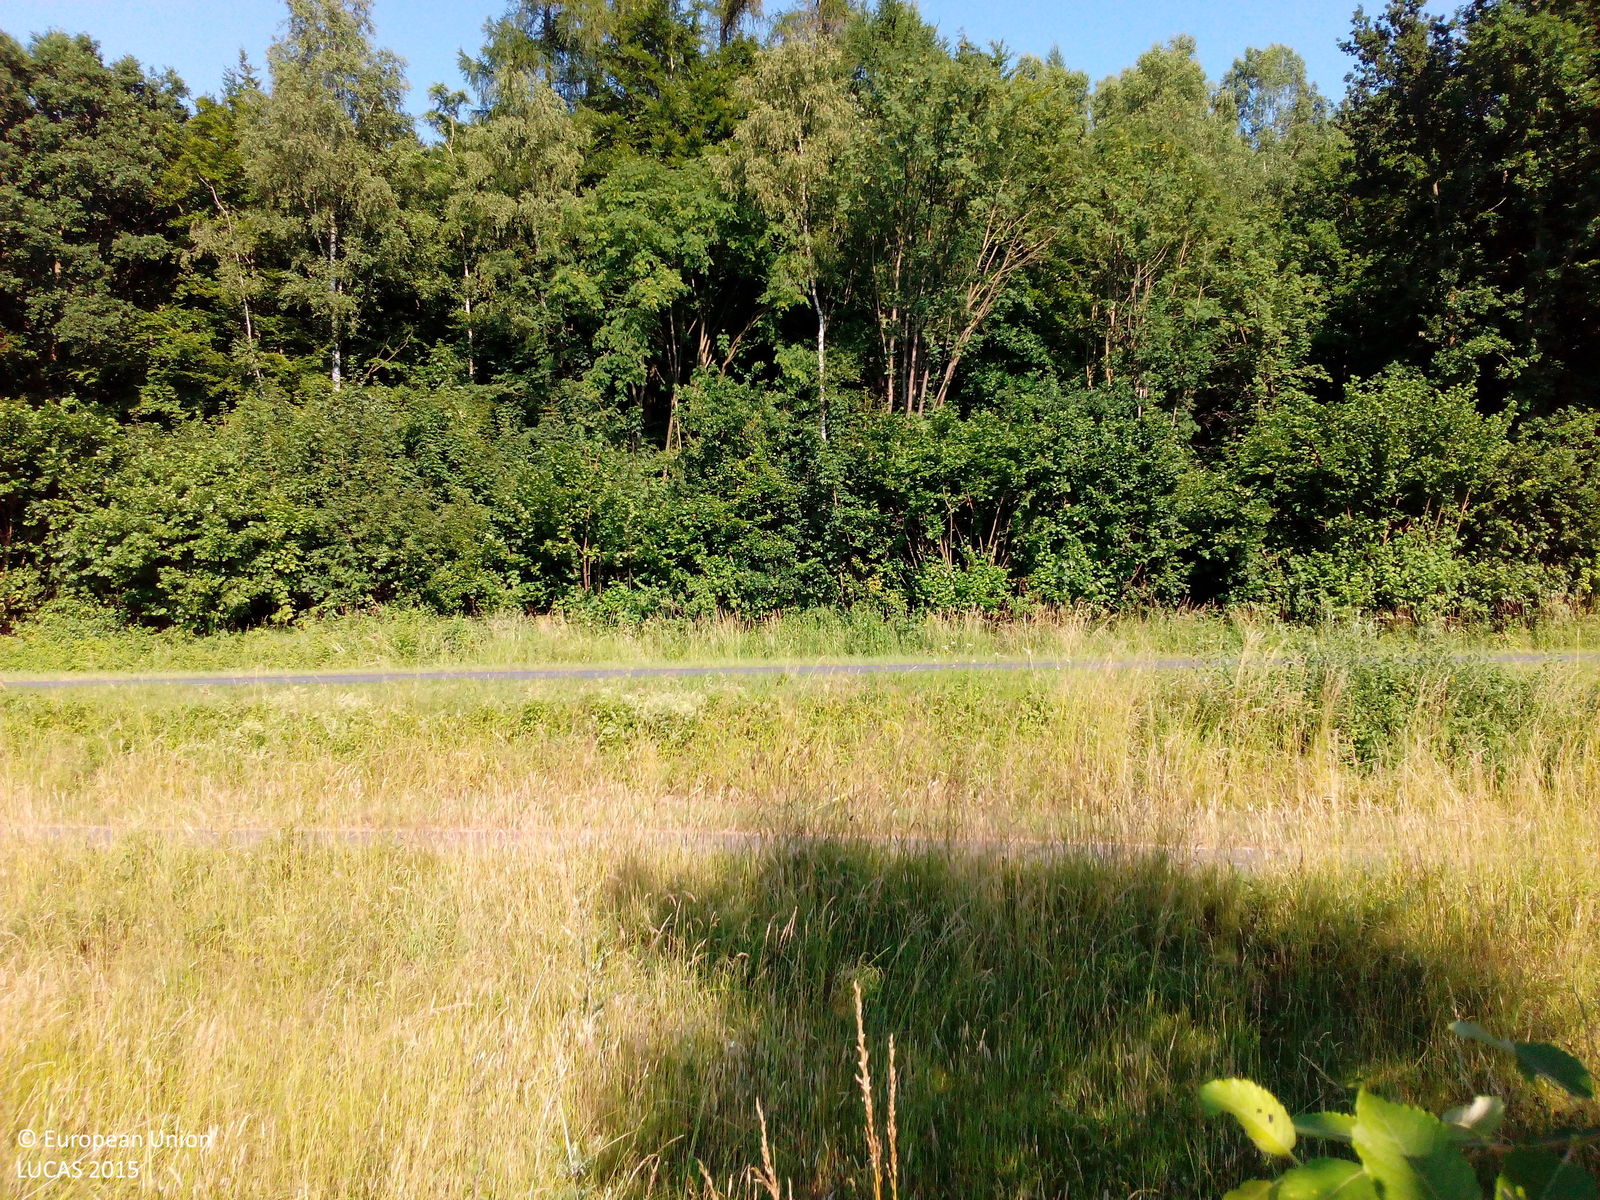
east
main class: Woodland
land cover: Broadleaved woodland
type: non-riverine alder, birch or aspen forest
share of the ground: > 75 %
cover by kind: broadleaved forest trees 75 %, herbaceous plants 15 %, shrubs 10 %
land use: Mining and quarrying
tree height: > 5 m
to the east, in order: Broadleaved woodland; Grassland with sparse tree/shrub cover; Paved roads, cycling and walking lanes; Grass margins; Abandoned hedges; Grass margins; Paved roads, cycling and walking lanes; Grass margins; Broadleaved woodland; Tracks; Broadleaved woodland
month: July
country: DE
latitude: 51.4602
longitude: 9.6403
